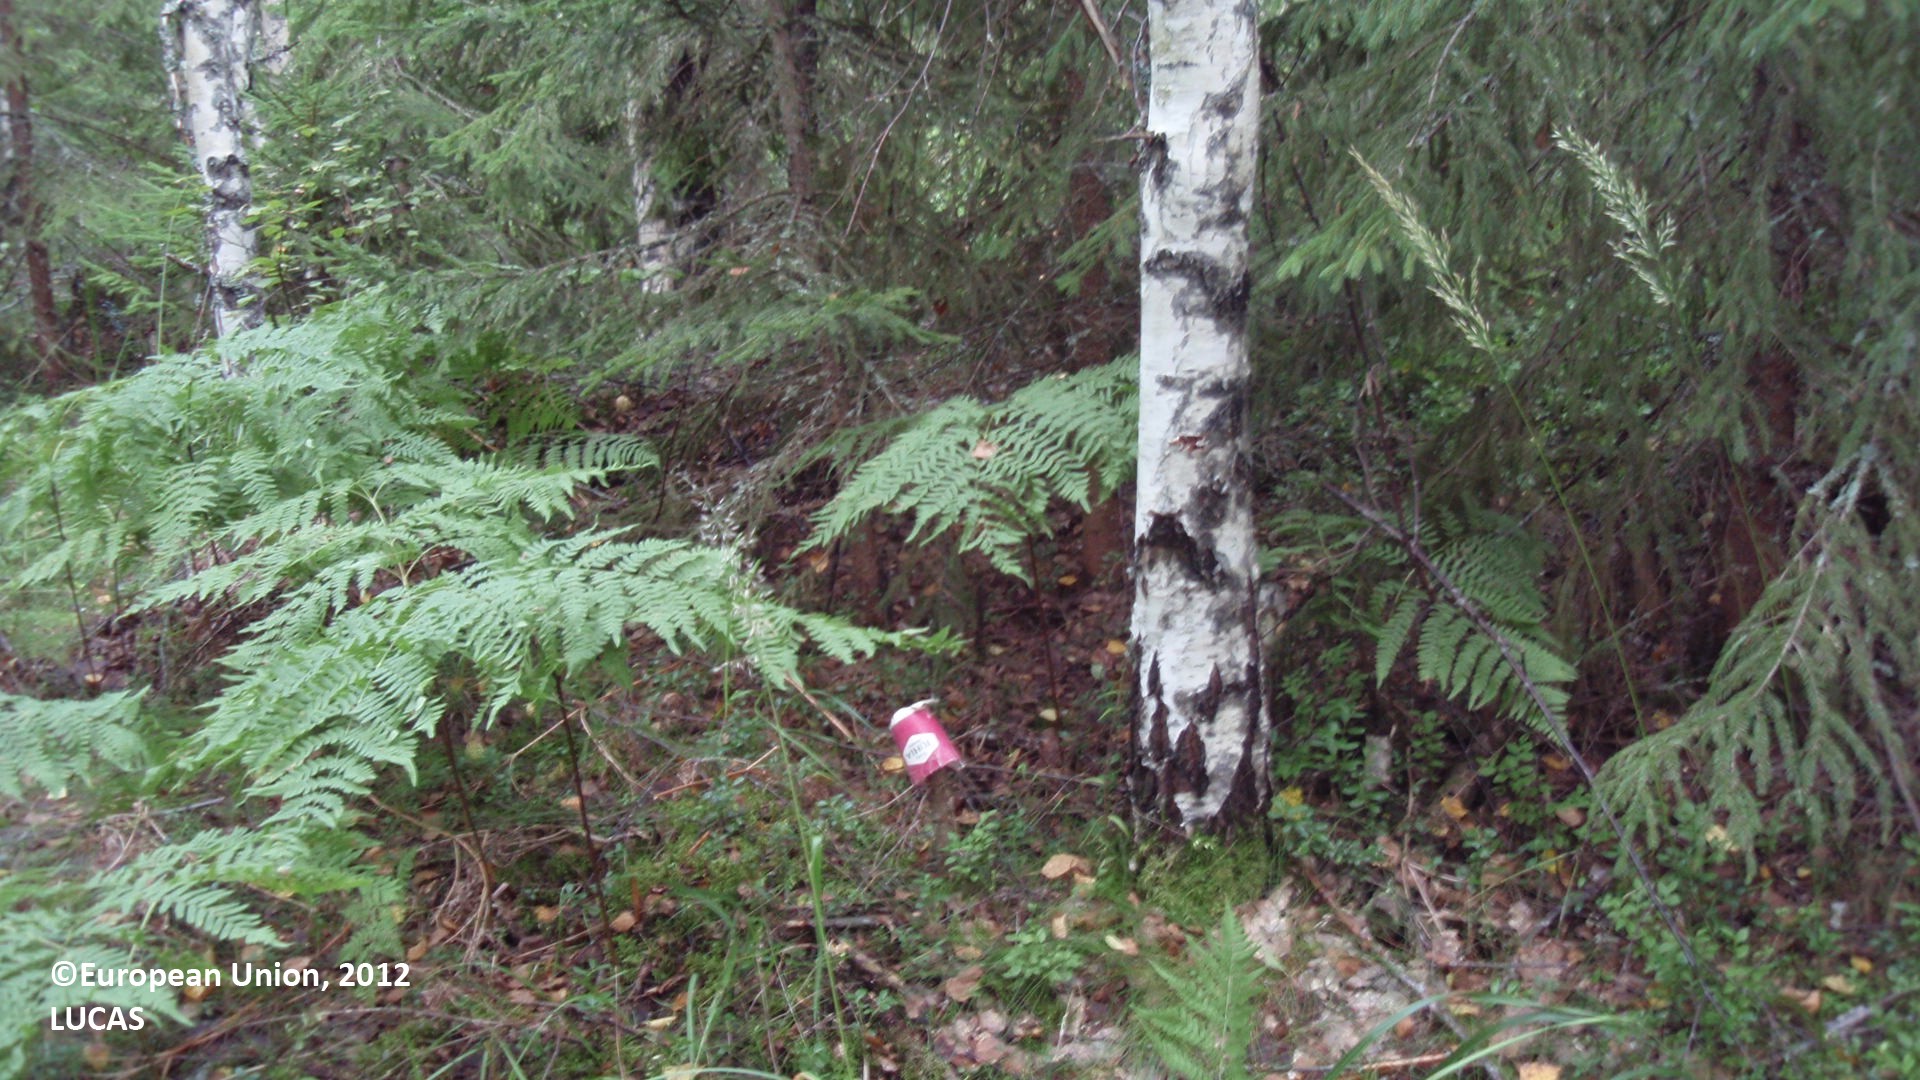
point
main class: Woodland
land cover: Spruce dominated mixed woodland
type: boreal forest
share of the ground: 50 - 75 %
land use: Forestry
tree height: > 5 m
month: August
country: FI
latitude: 60.9290
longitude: 27.3167
